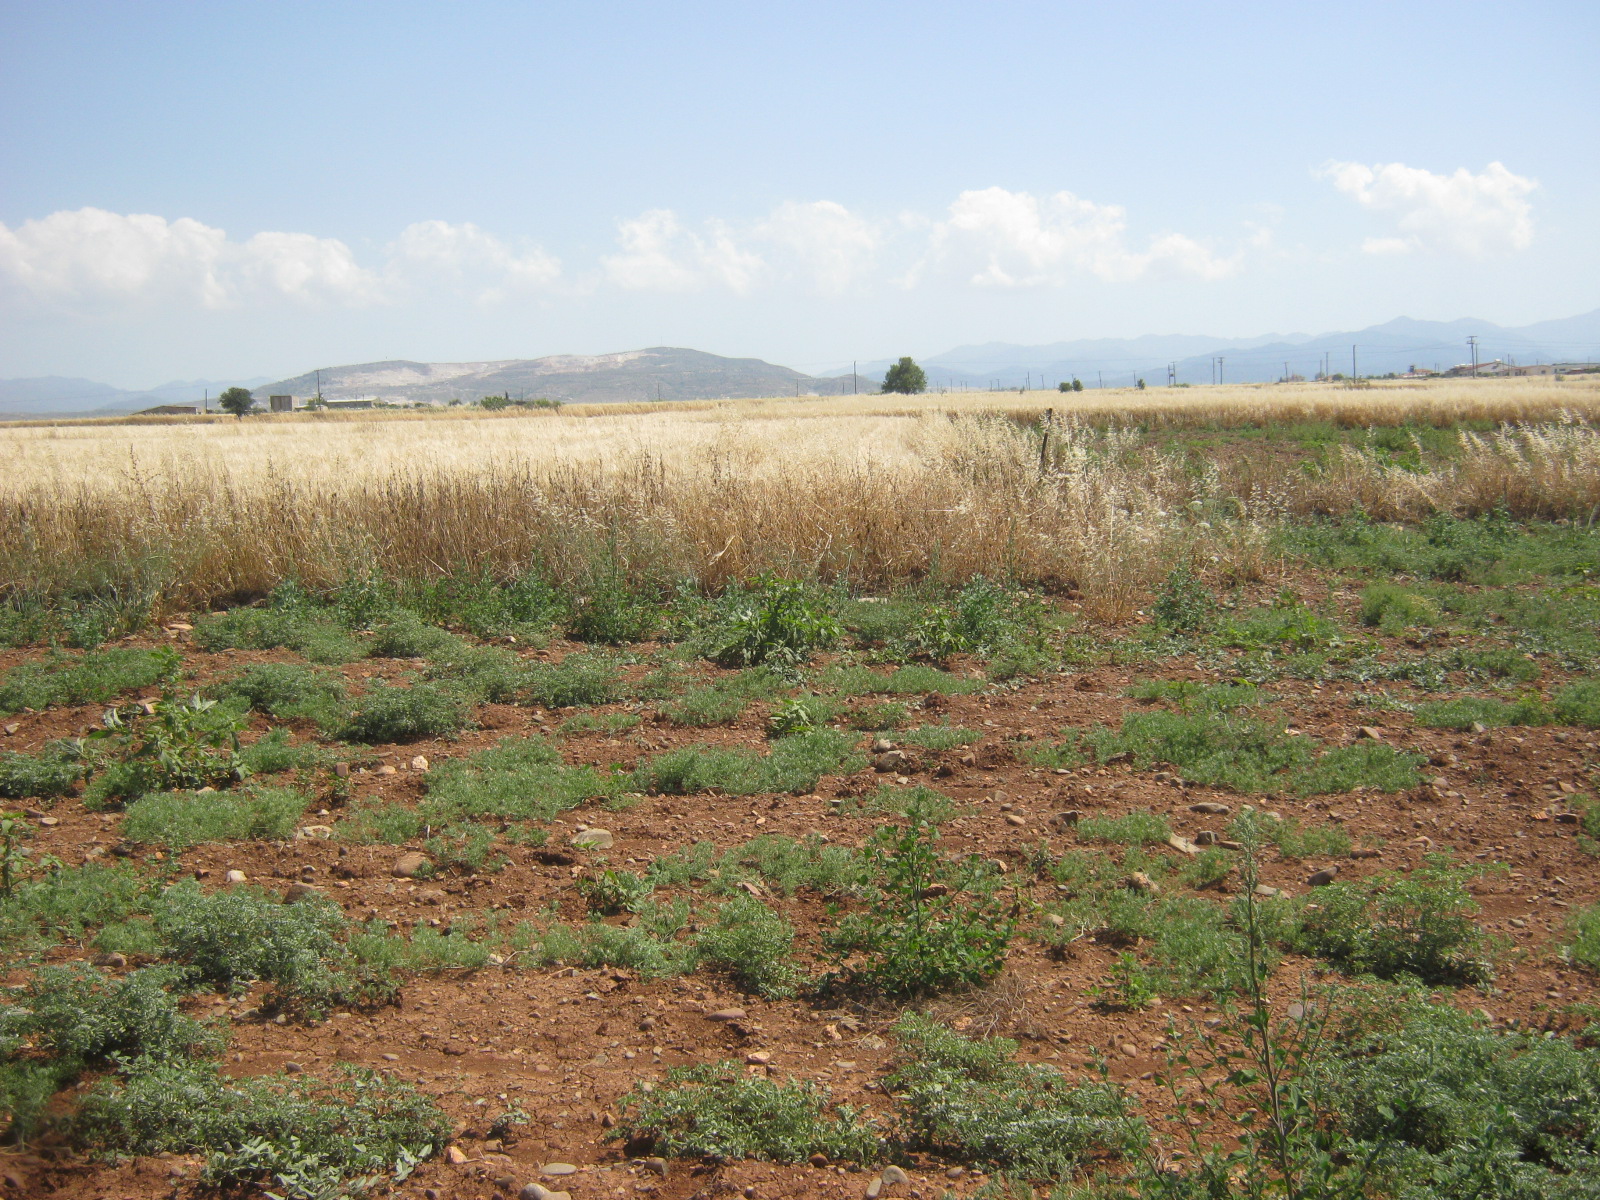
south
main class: Grassland
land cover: Spontaneously vegetated surfaces
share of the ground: 10 - 25 %
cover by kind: unconsolidated bare surface 75 %, herbaceous plants 25 %
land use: Fallow land
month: May
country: CY
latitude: 35.1061
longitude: 33.0996
